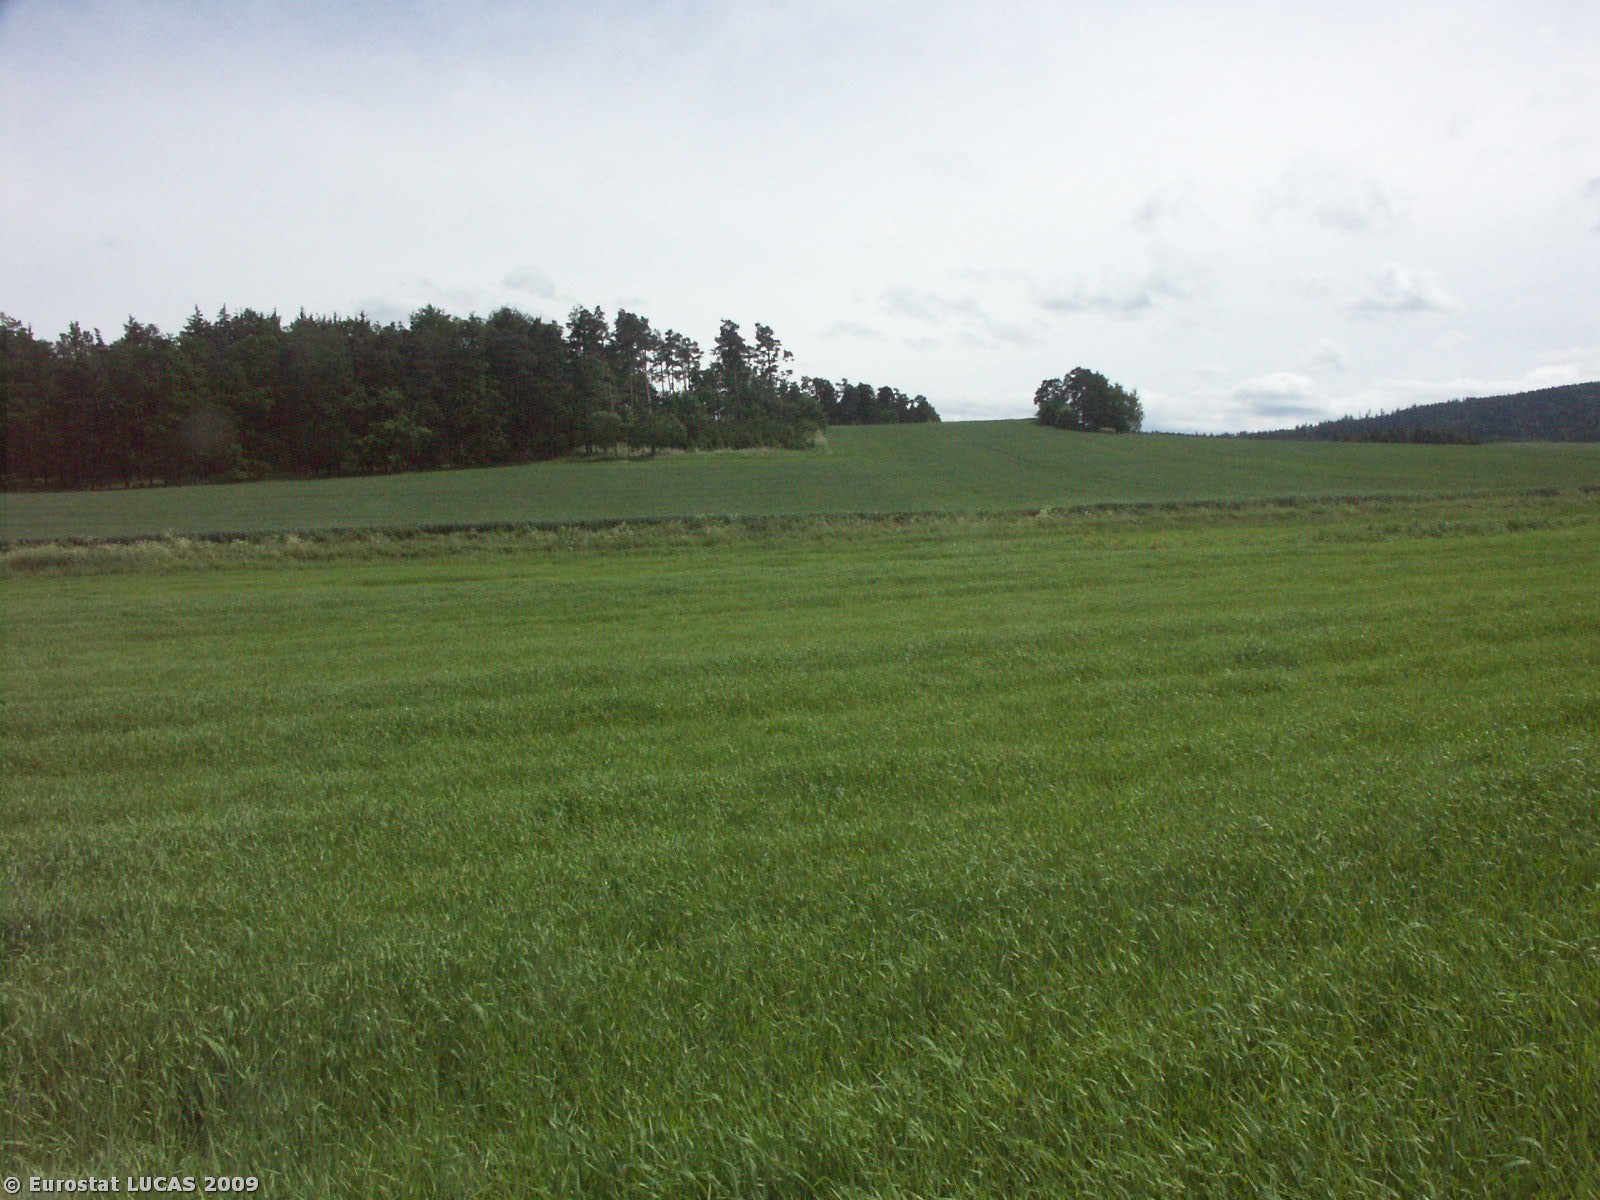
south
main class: Cropland
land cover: Barley
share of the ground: > 75 %
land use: Agriculture (excluding fallow land and kitchen gardens)
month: May
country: CZ
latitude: 48.9684
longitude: 14.3038
